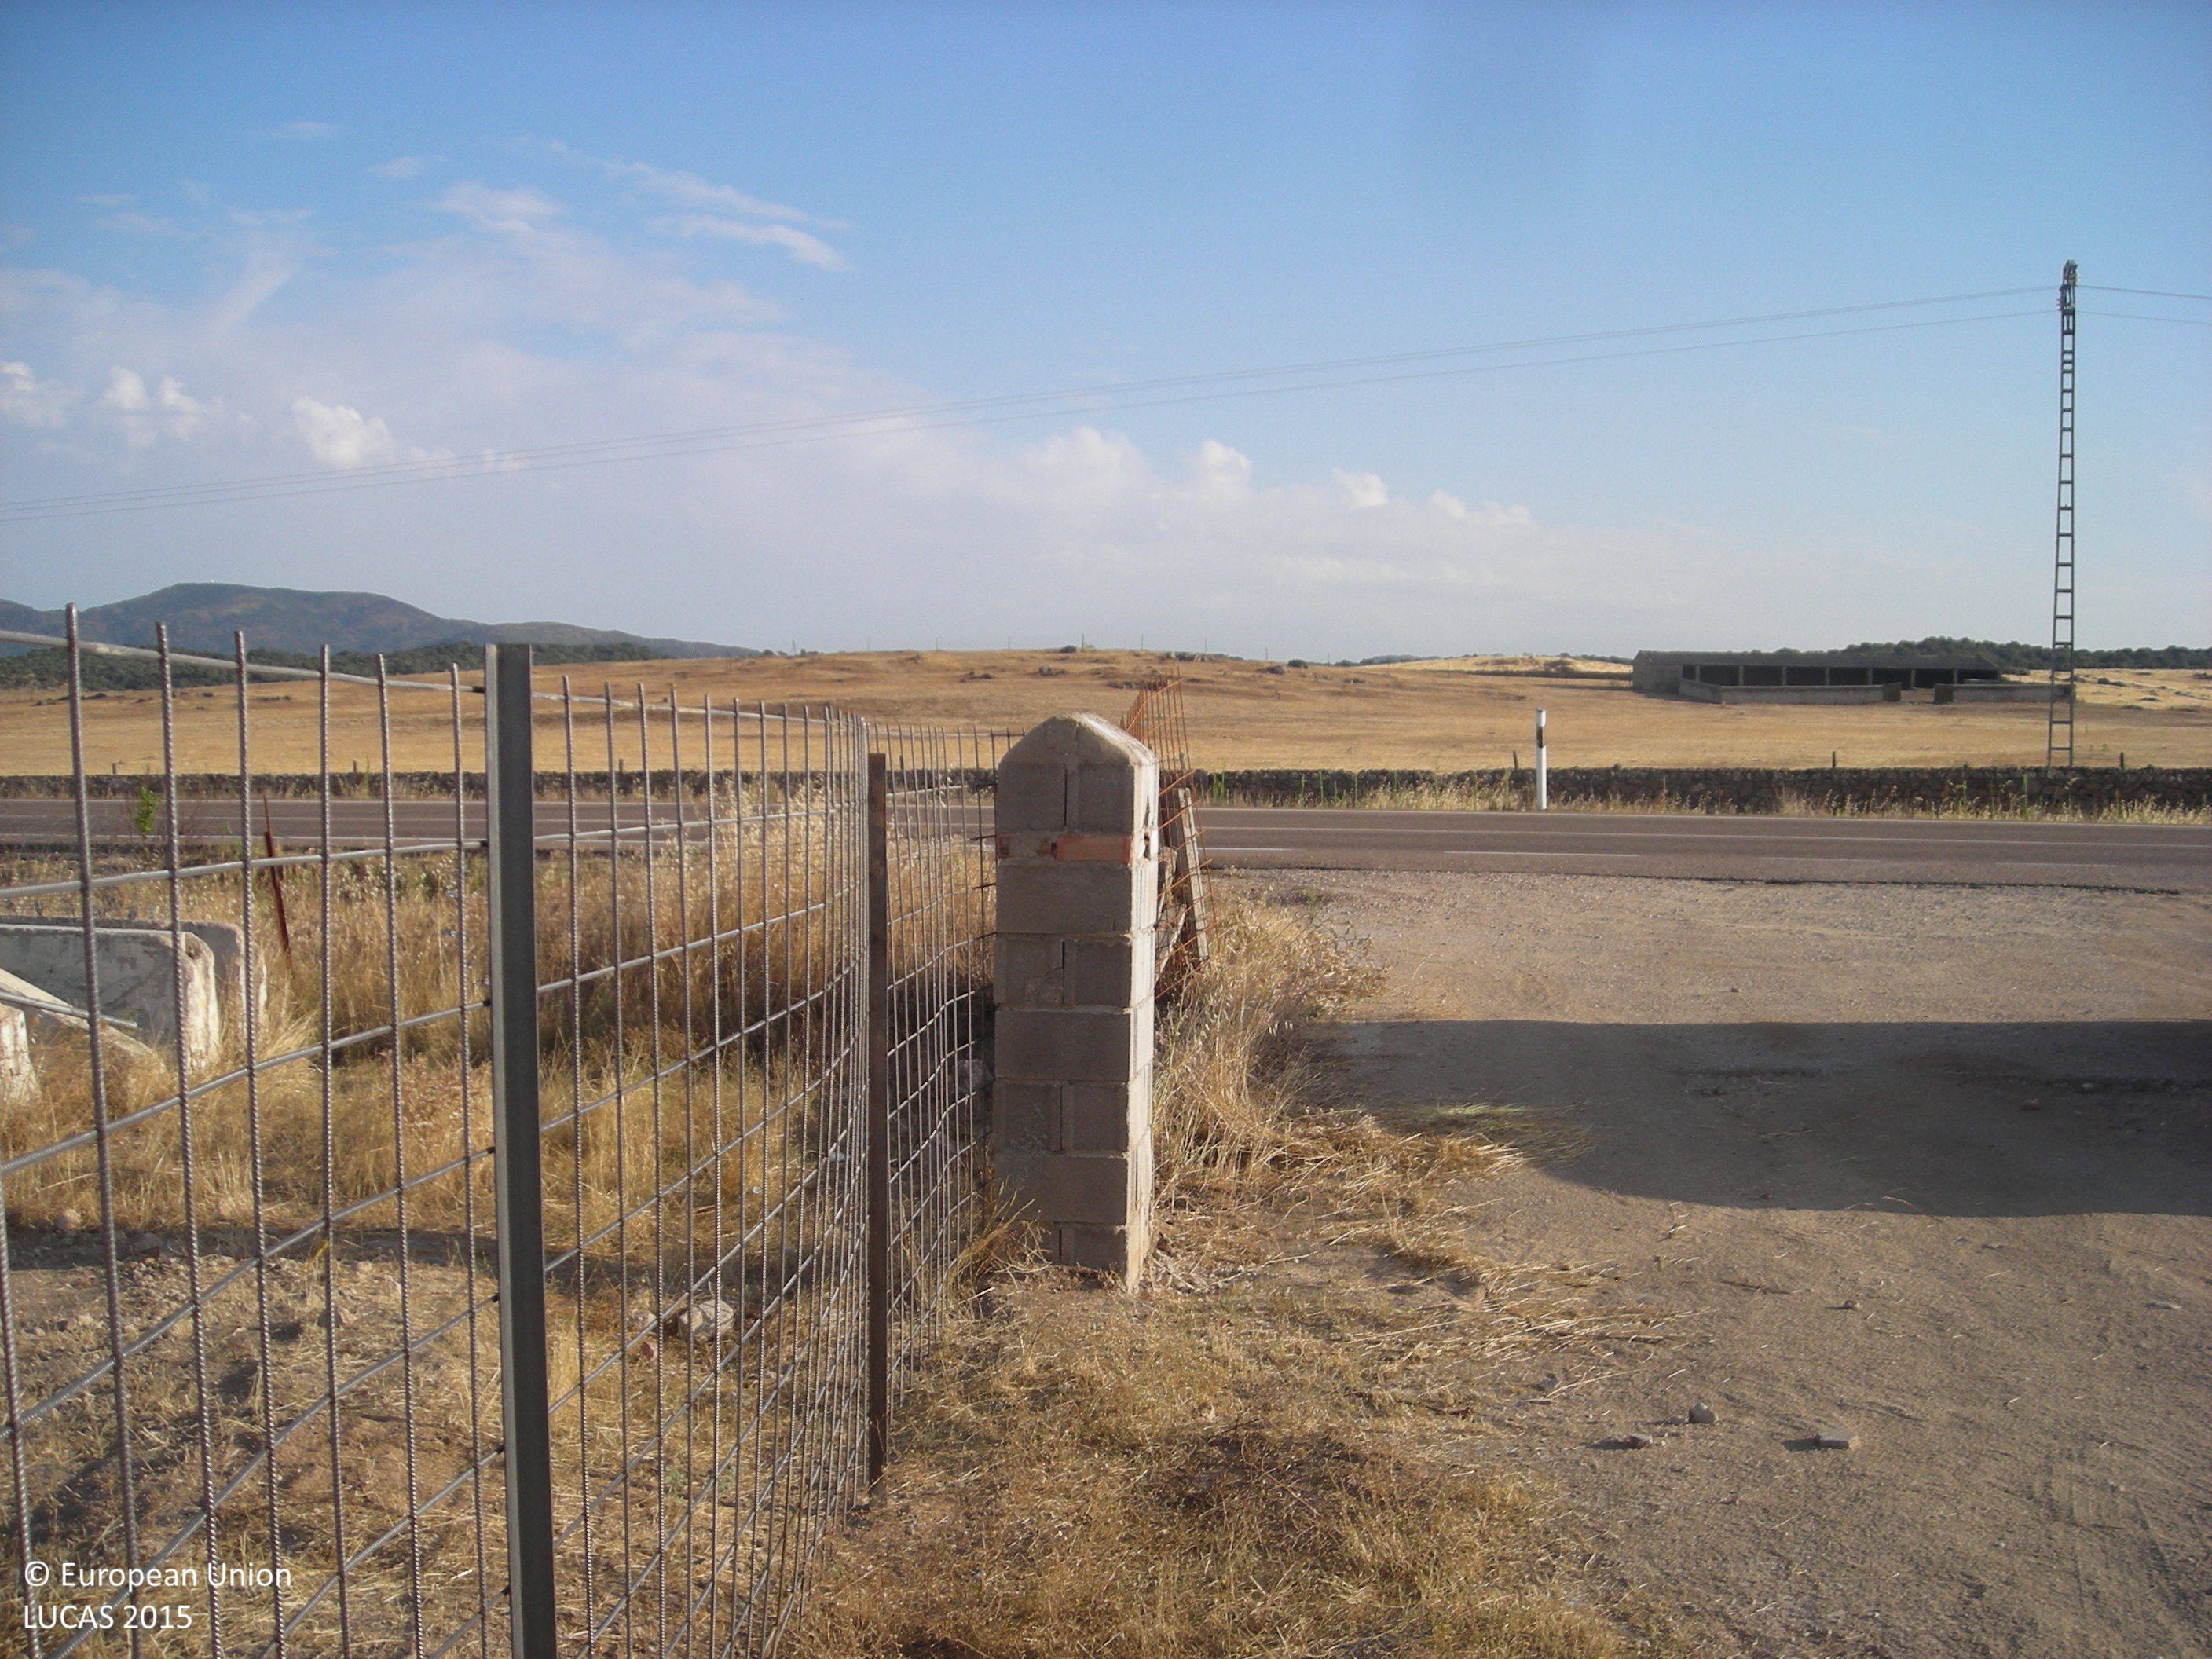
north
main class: Grassland
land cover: Spontaneously vegetated surfaces
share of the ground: > 75 %
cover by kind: herbaceous plants 100 %
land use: Agriculture (excluding fallow land and kitchen gardens)
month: July
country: ES
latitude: 39.1352
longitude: -5.9612
